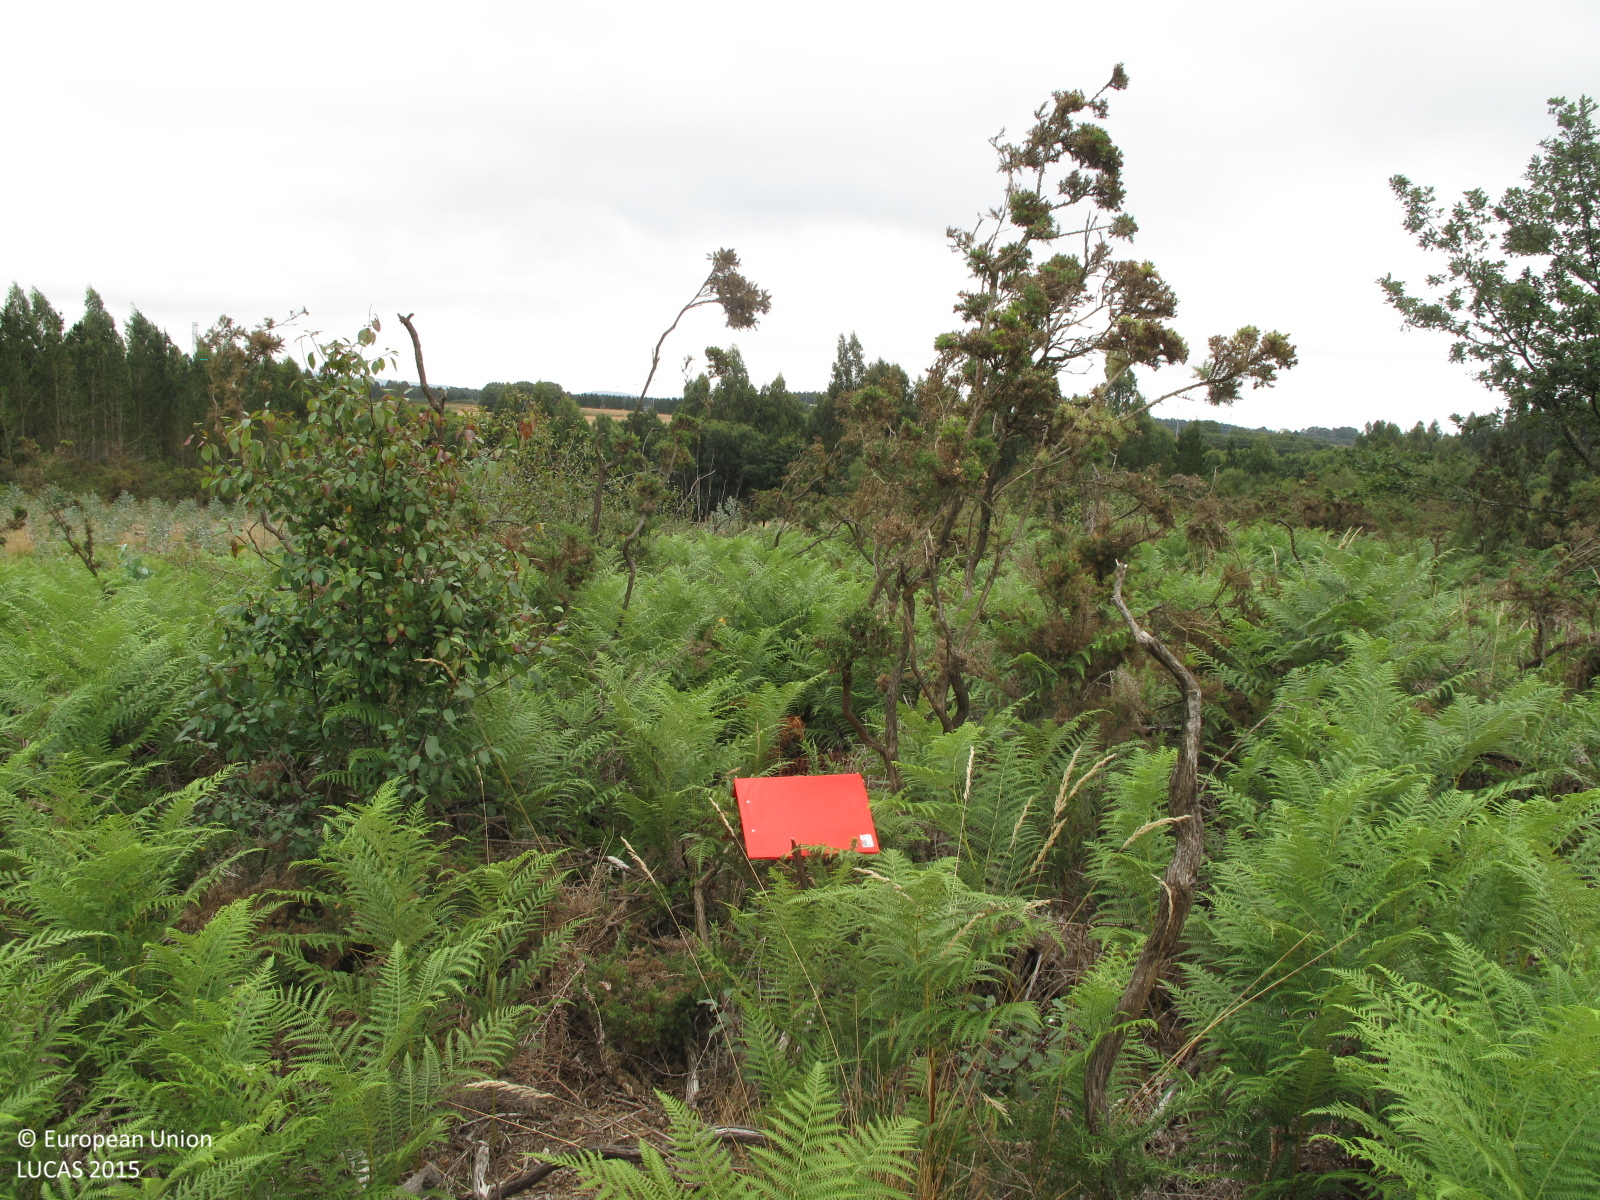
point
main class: Shrubland
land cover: Shrubland with sparse tree cover
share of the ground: 10 - 25 %
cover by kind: herbaceous plants 70 %, shrubs 15 %, lichens and mosses 10 %, broadleaved forest trees 5 %
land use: Abandoned areas
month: July
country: ES
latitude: 43.1683
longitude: -7.9887
